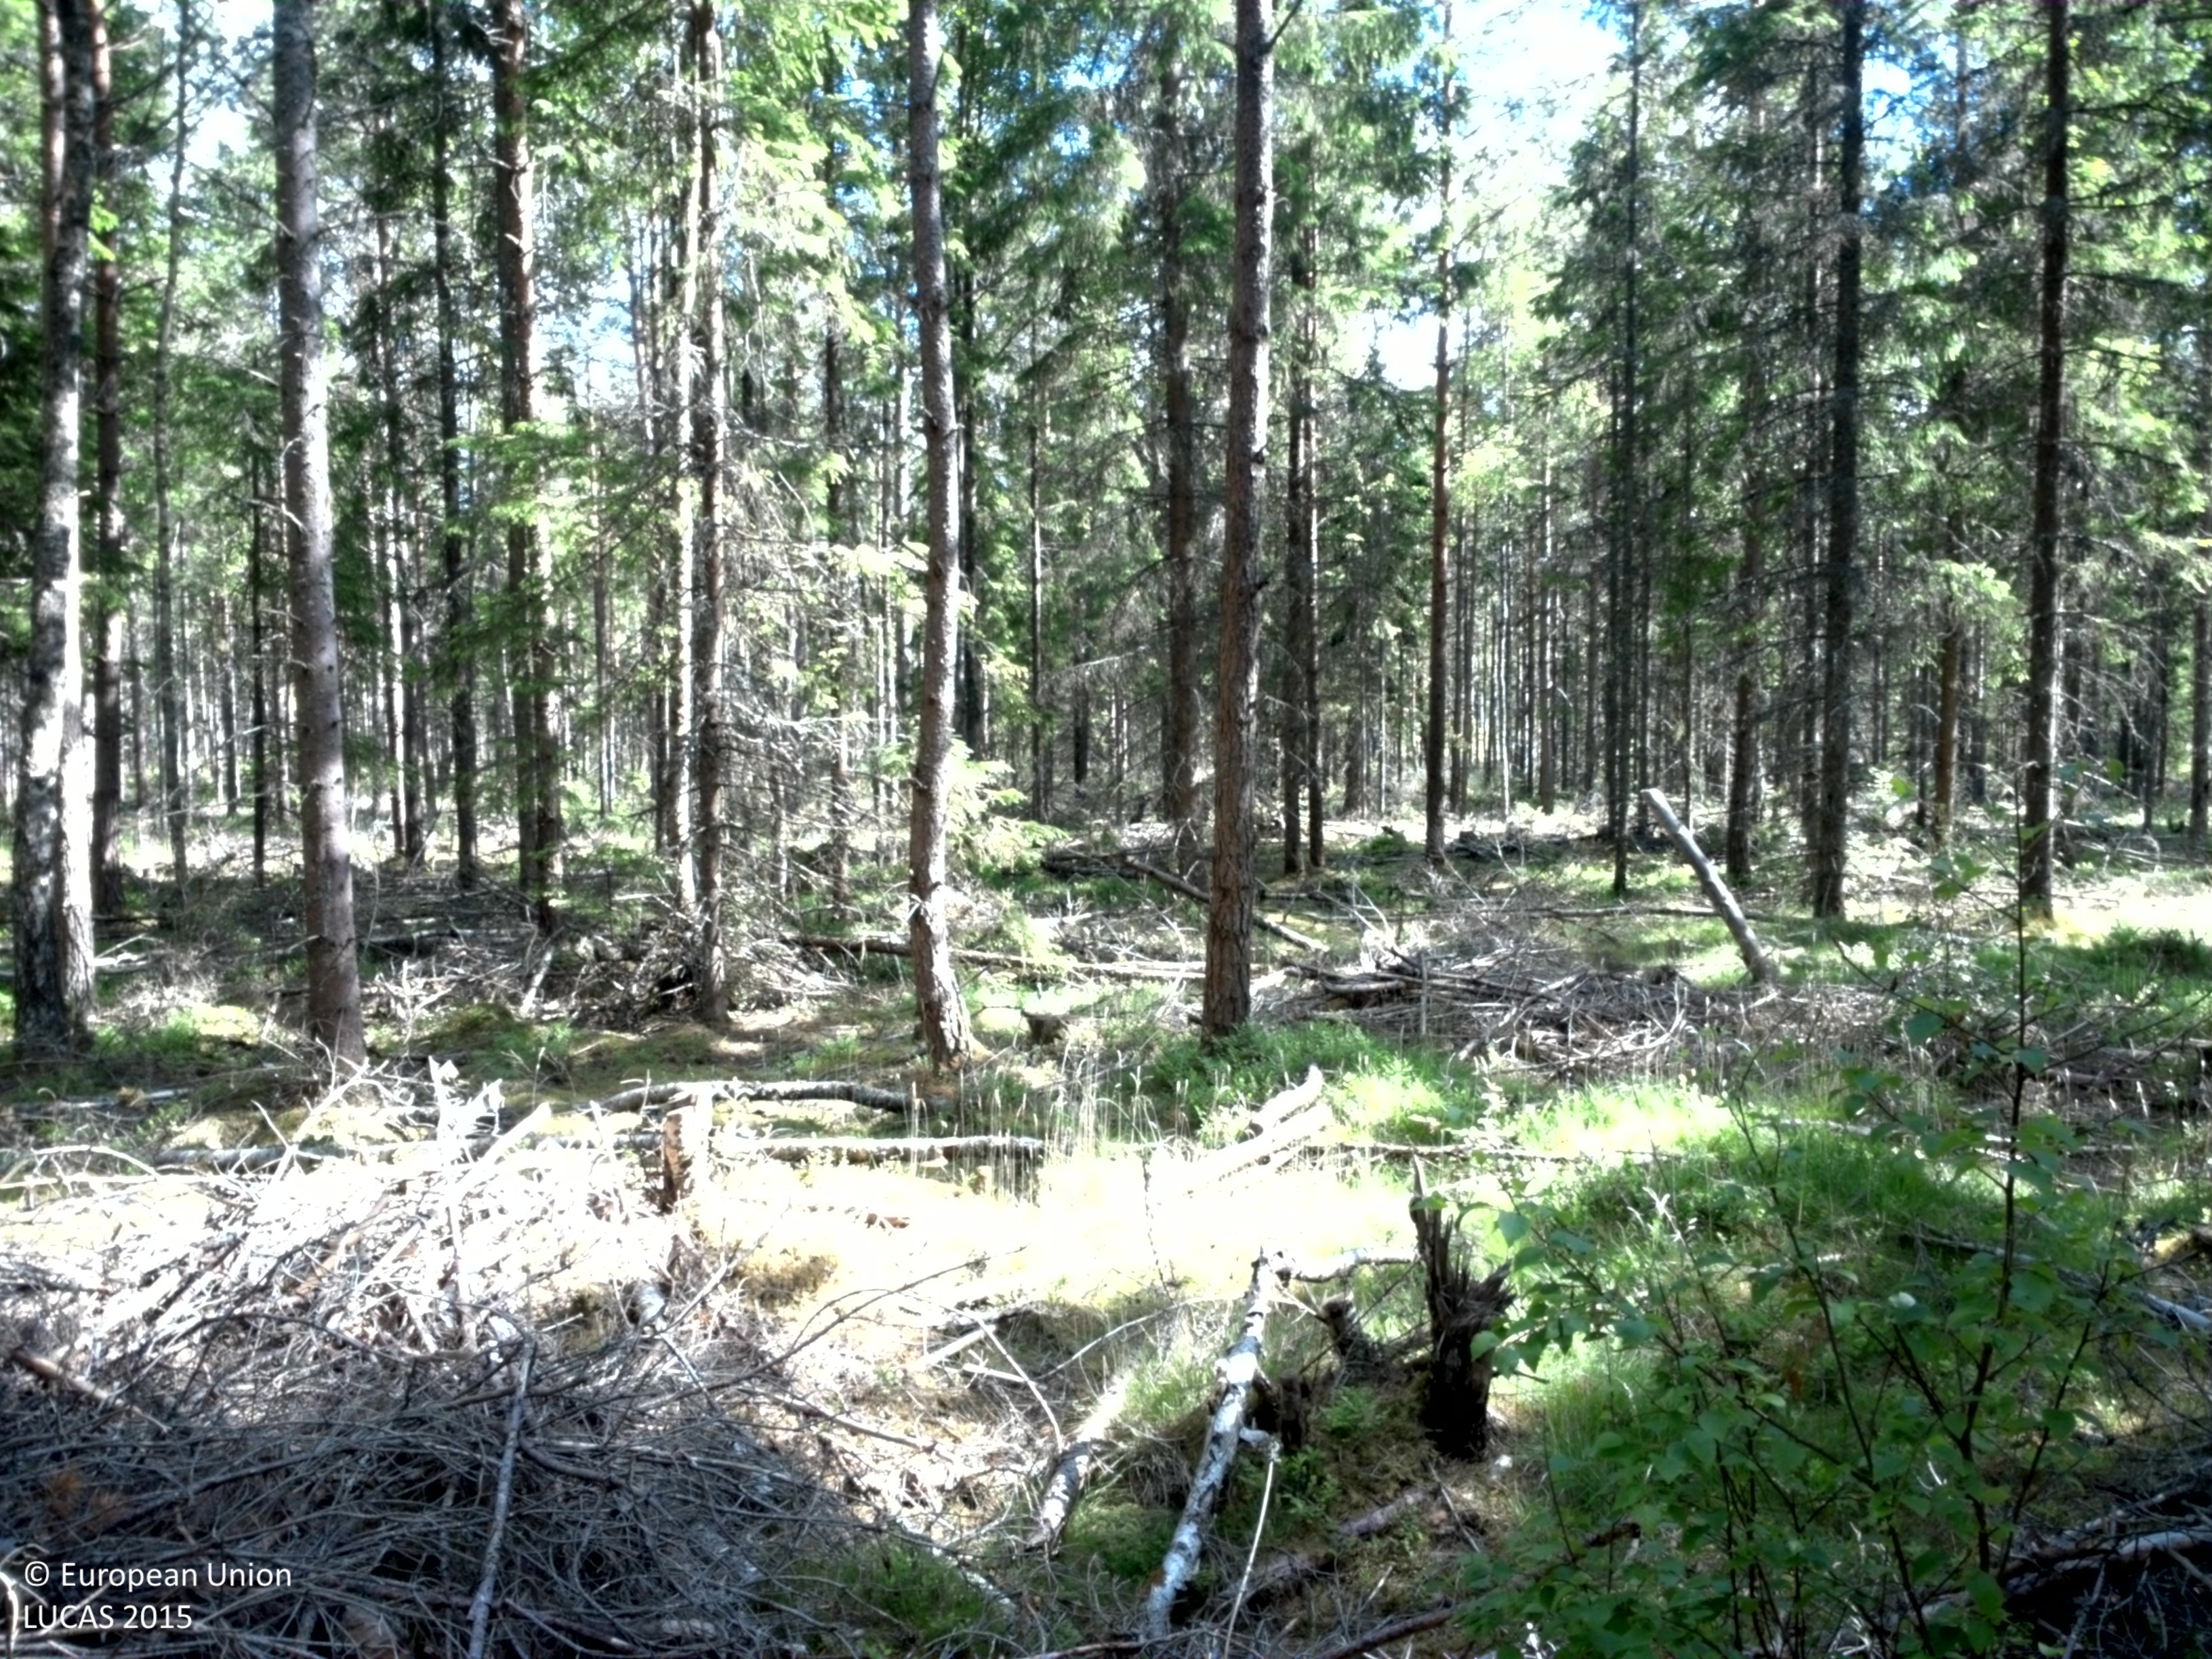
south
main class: Woodland
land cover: Pine dominated coniferous woodland
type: boreal forest
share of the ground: 50 - 75 %
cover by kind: coniferous forest trees 65 %, lichens and mosses 25 %, broadleaved forest trees 10 %
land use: Forestry
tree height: > 5 m
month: June
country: SE
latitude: 57.7854
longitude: 13.8801
